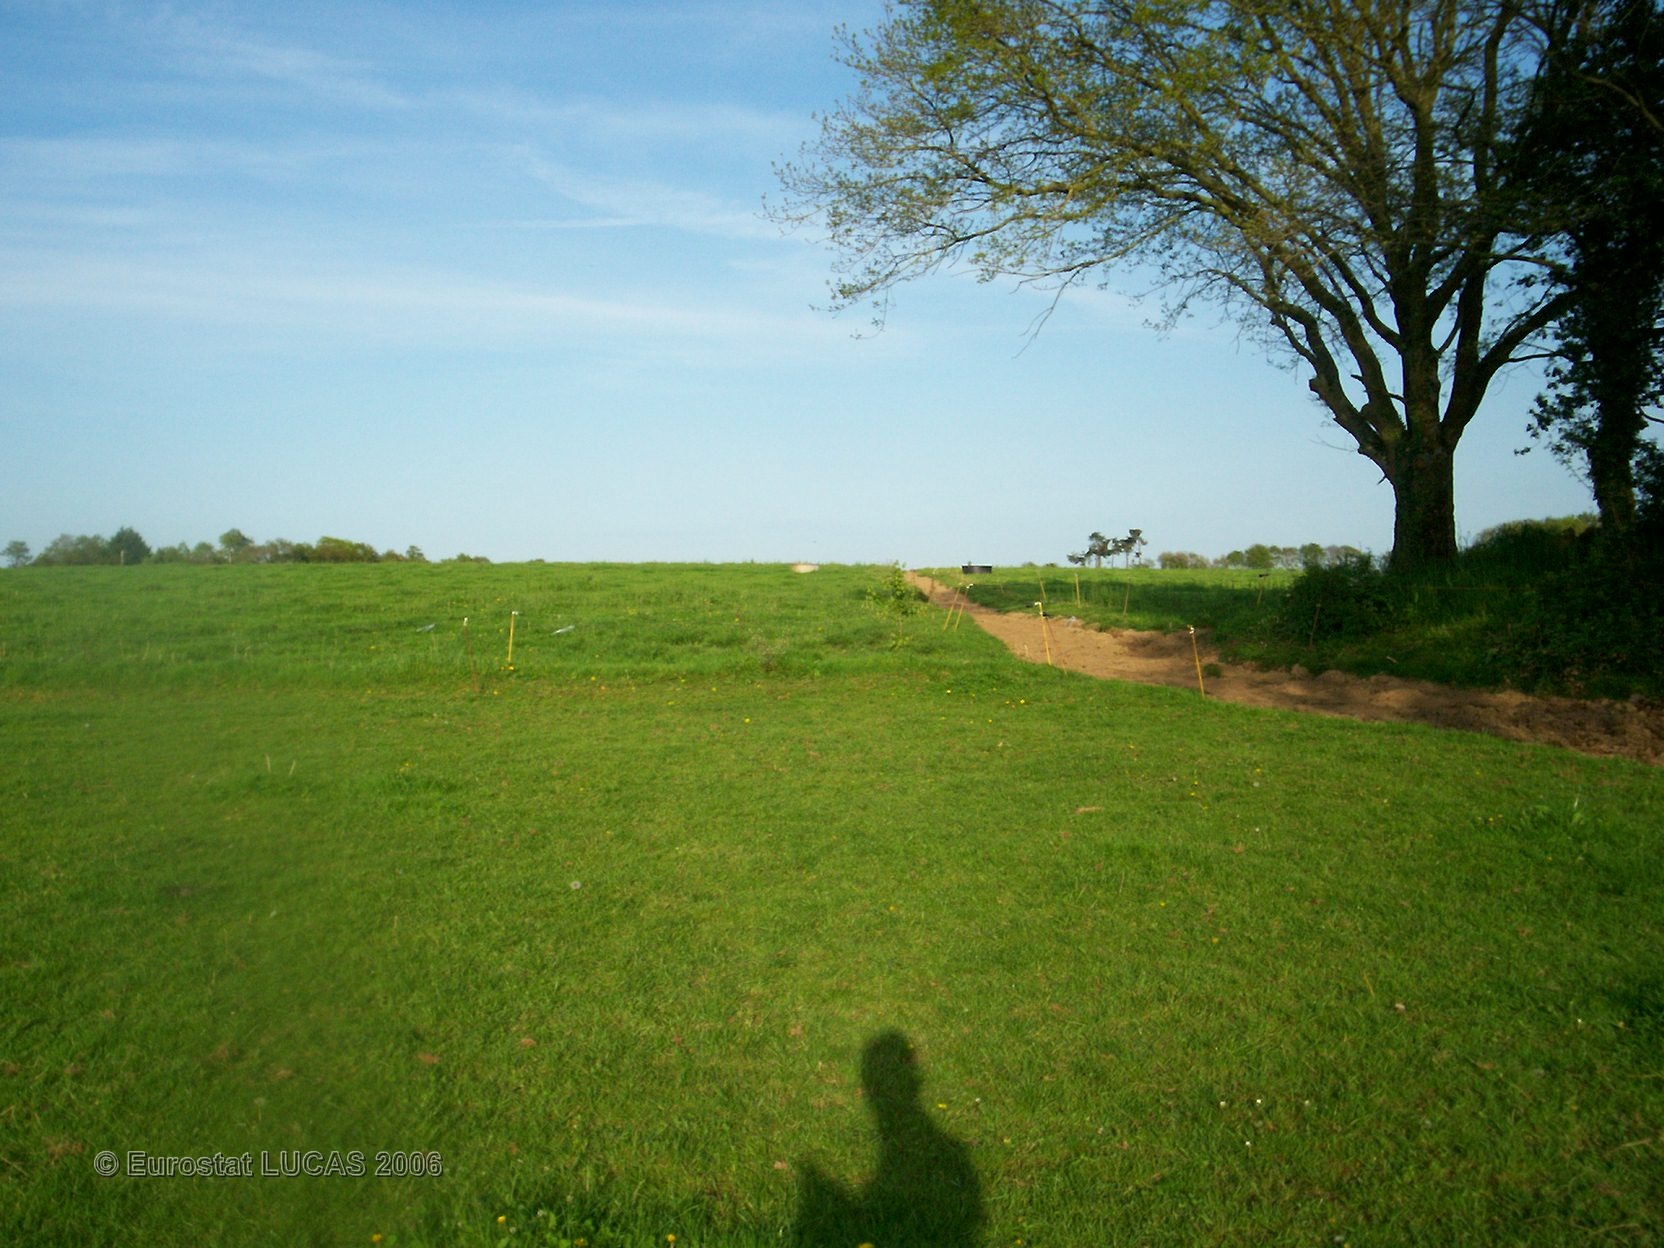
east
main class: Grassland
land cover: Grassland without tree/shrub cover
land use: Agriculture (excluding fallow land and kitchen gardens)
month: May
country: FR
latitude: 47.9945
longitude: -2.8635
